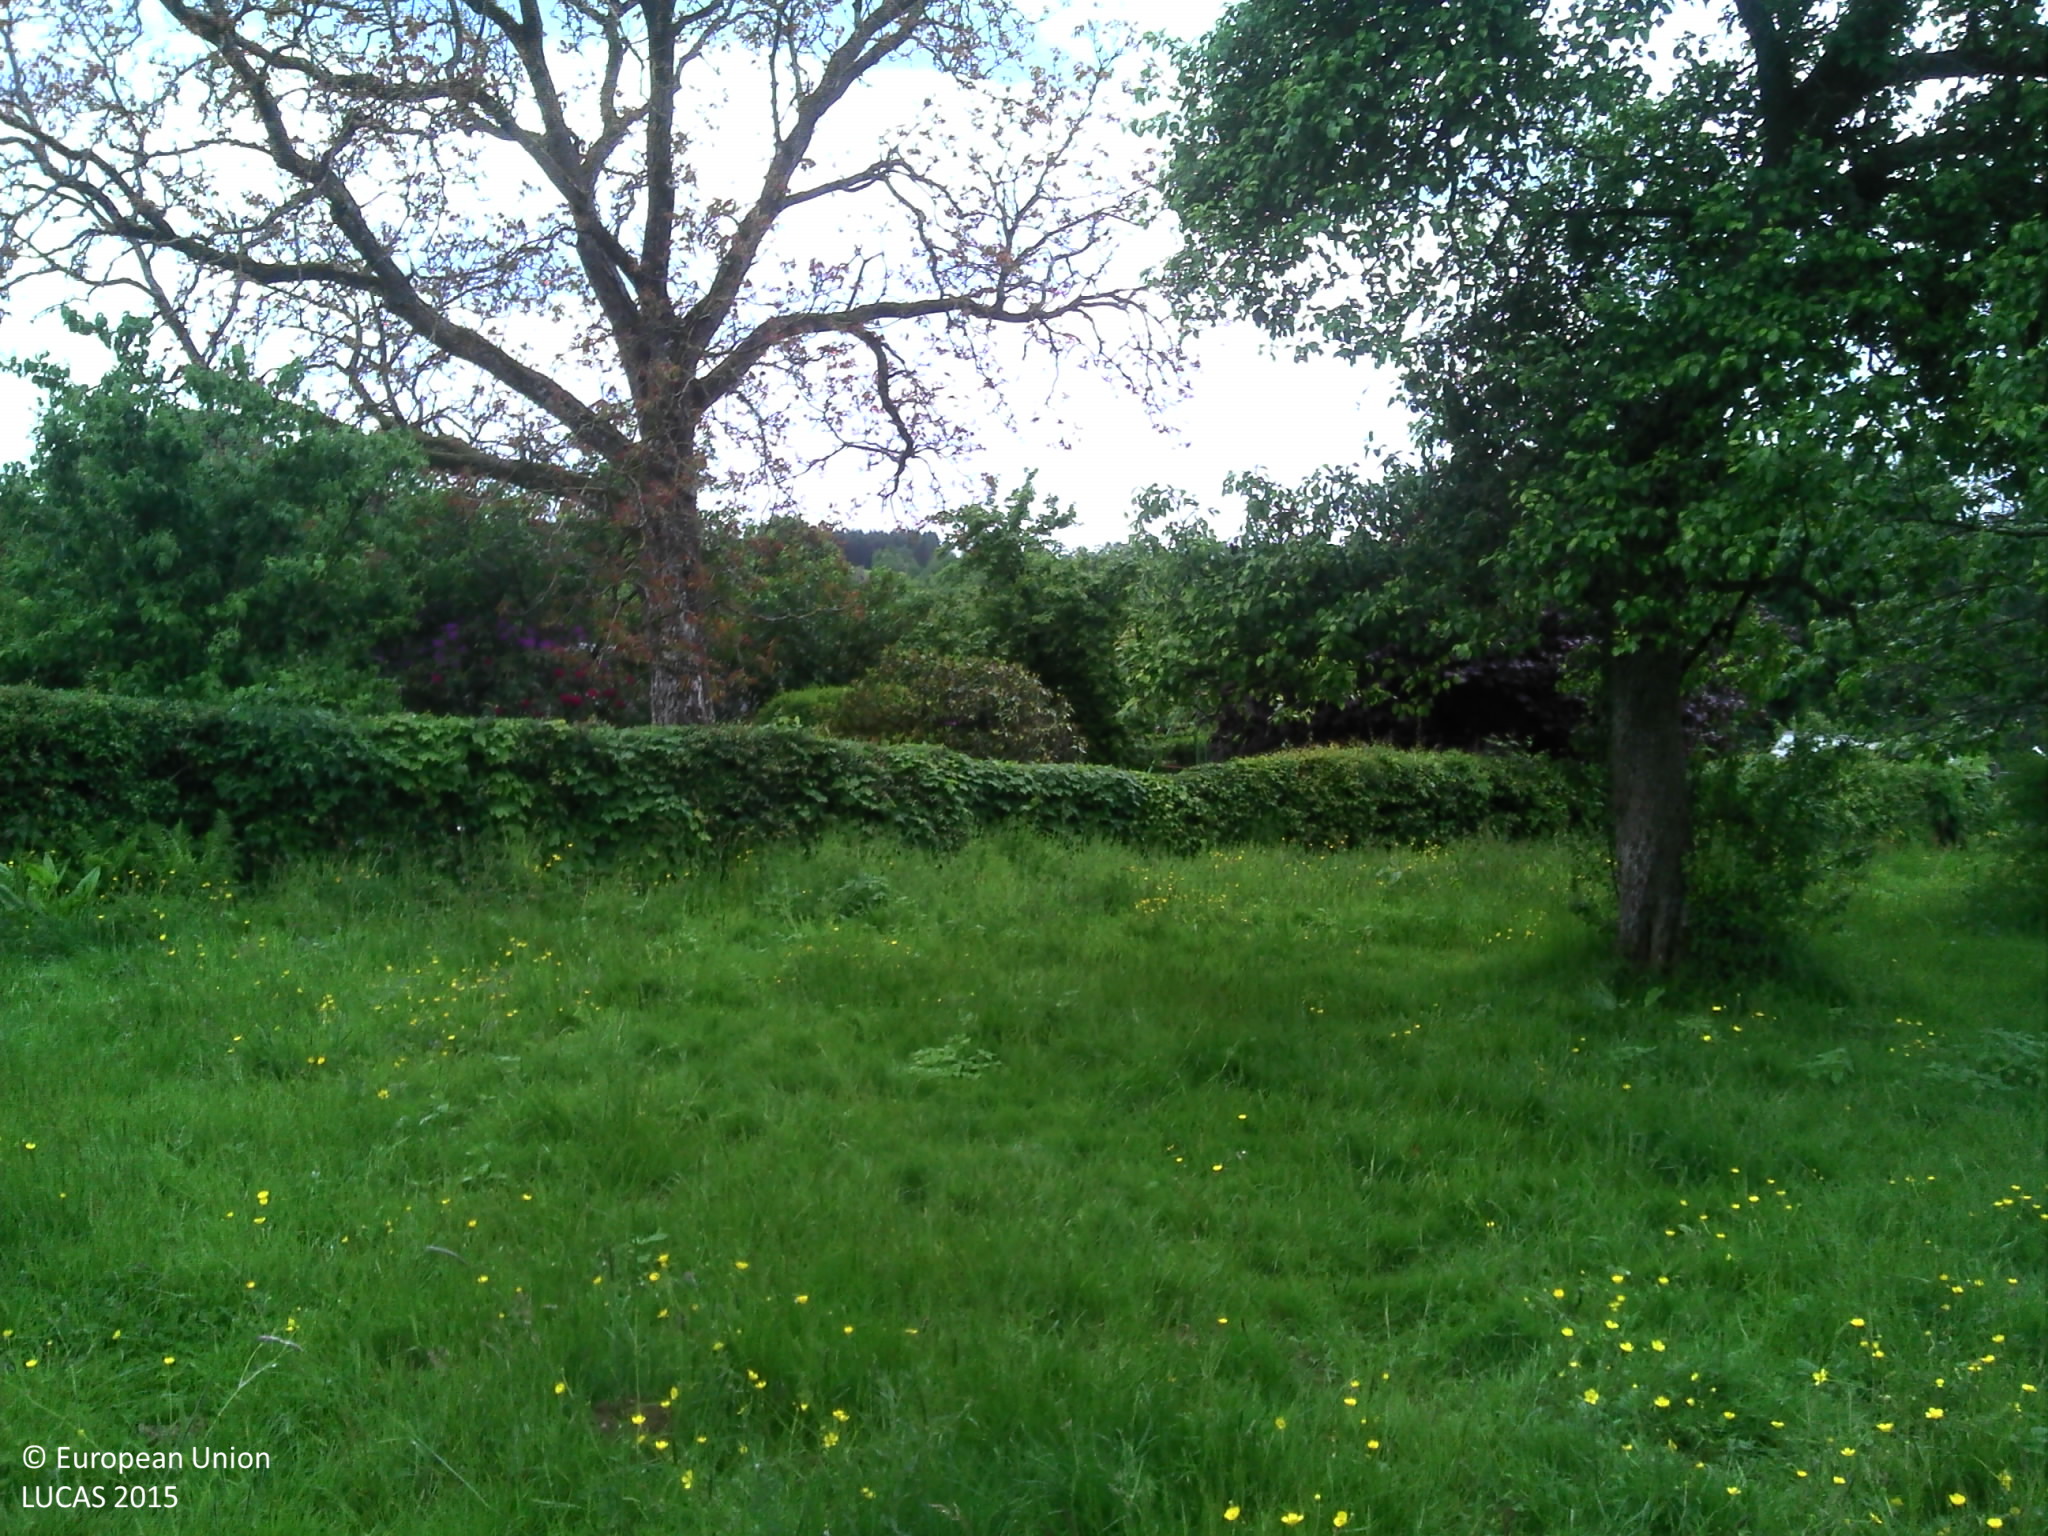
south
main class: Grassland
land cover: Grassland with sparse tree/shrub cover
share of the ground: > 75 %
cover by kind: herbaceous plants 90 %, broadleaved forest trees 5 %, unconsolidated bare surface 5 %
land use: Residential
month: June
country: BE
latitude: 49.8177
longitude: 4.8964
